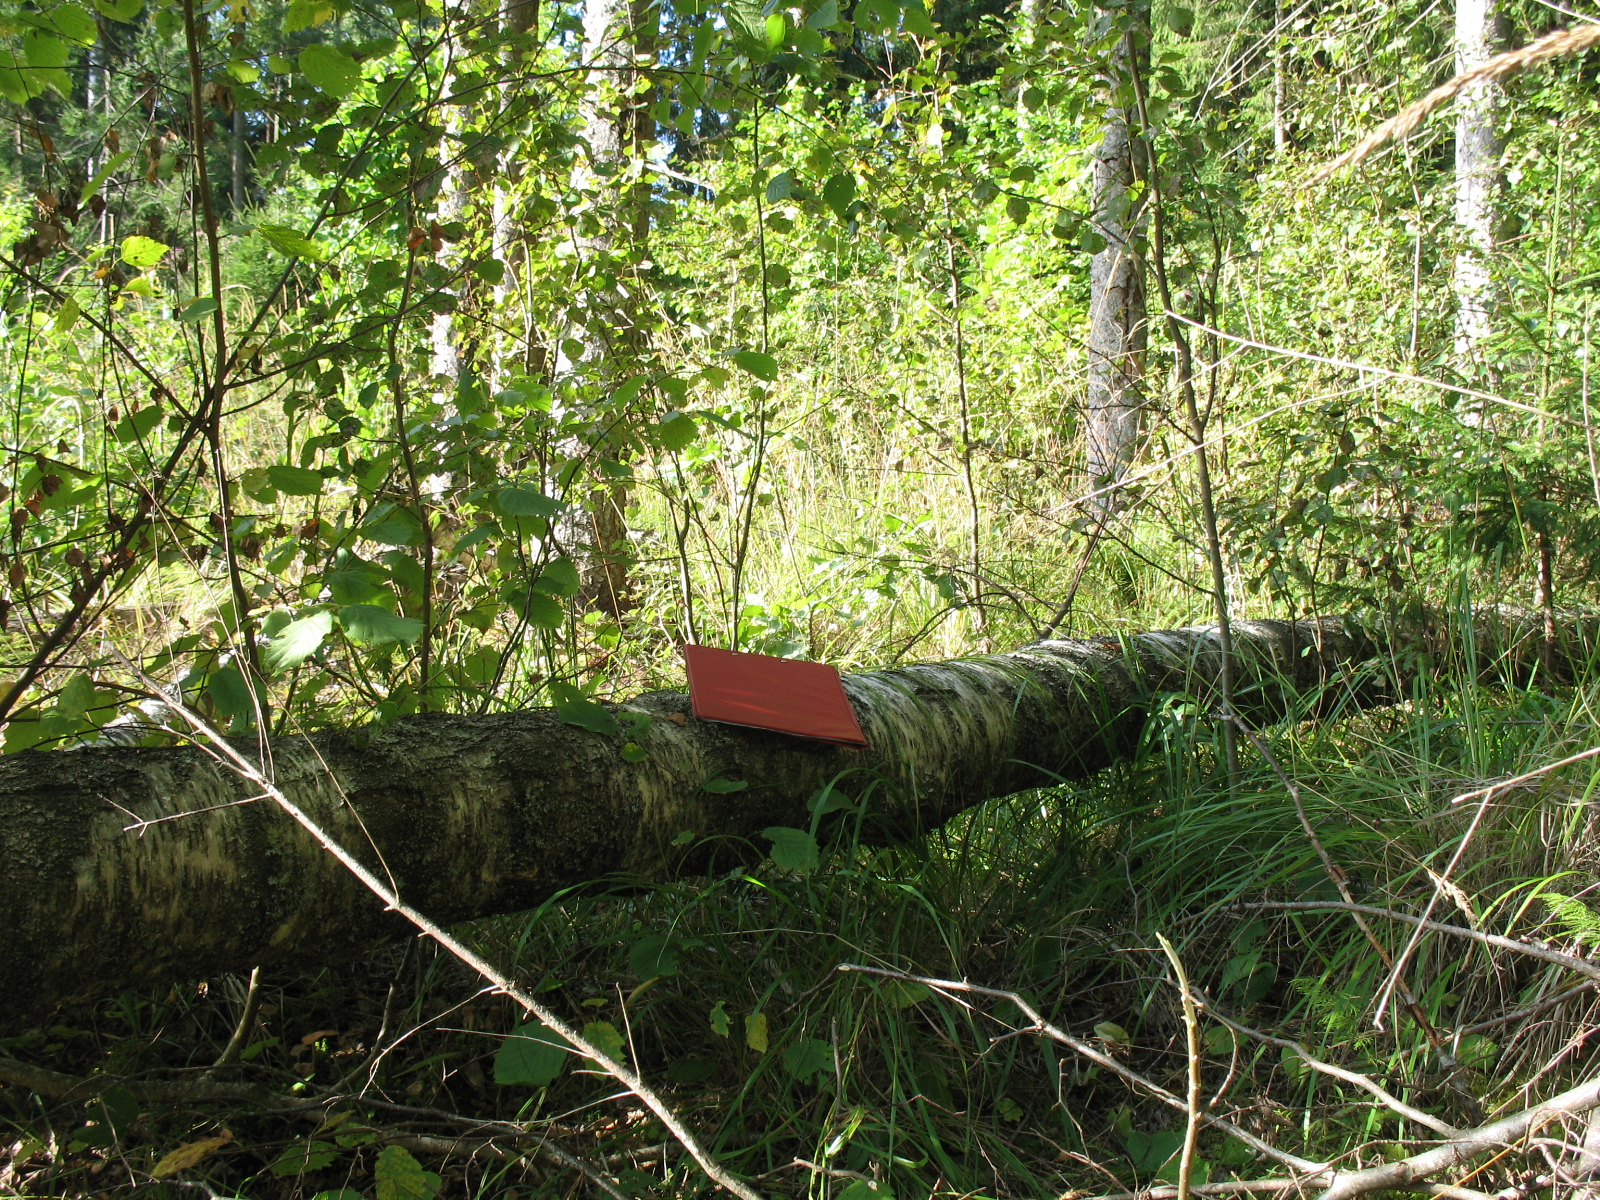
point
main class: Woodland
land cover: Spruce dominated mixed woodland
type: hemiboreal forest and nemoral coniferous forest and mixed broadleaved-coniferous forest
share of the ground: 50 - 75 %
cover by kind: coniferous forest trees 40 %, broadleaved forest trees 30 %, shrubs 20 %, herbaceous plants 10 %
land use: Forestry
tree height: > 5 m
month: August
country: LV
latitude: 56.3666
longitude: 26.0155
